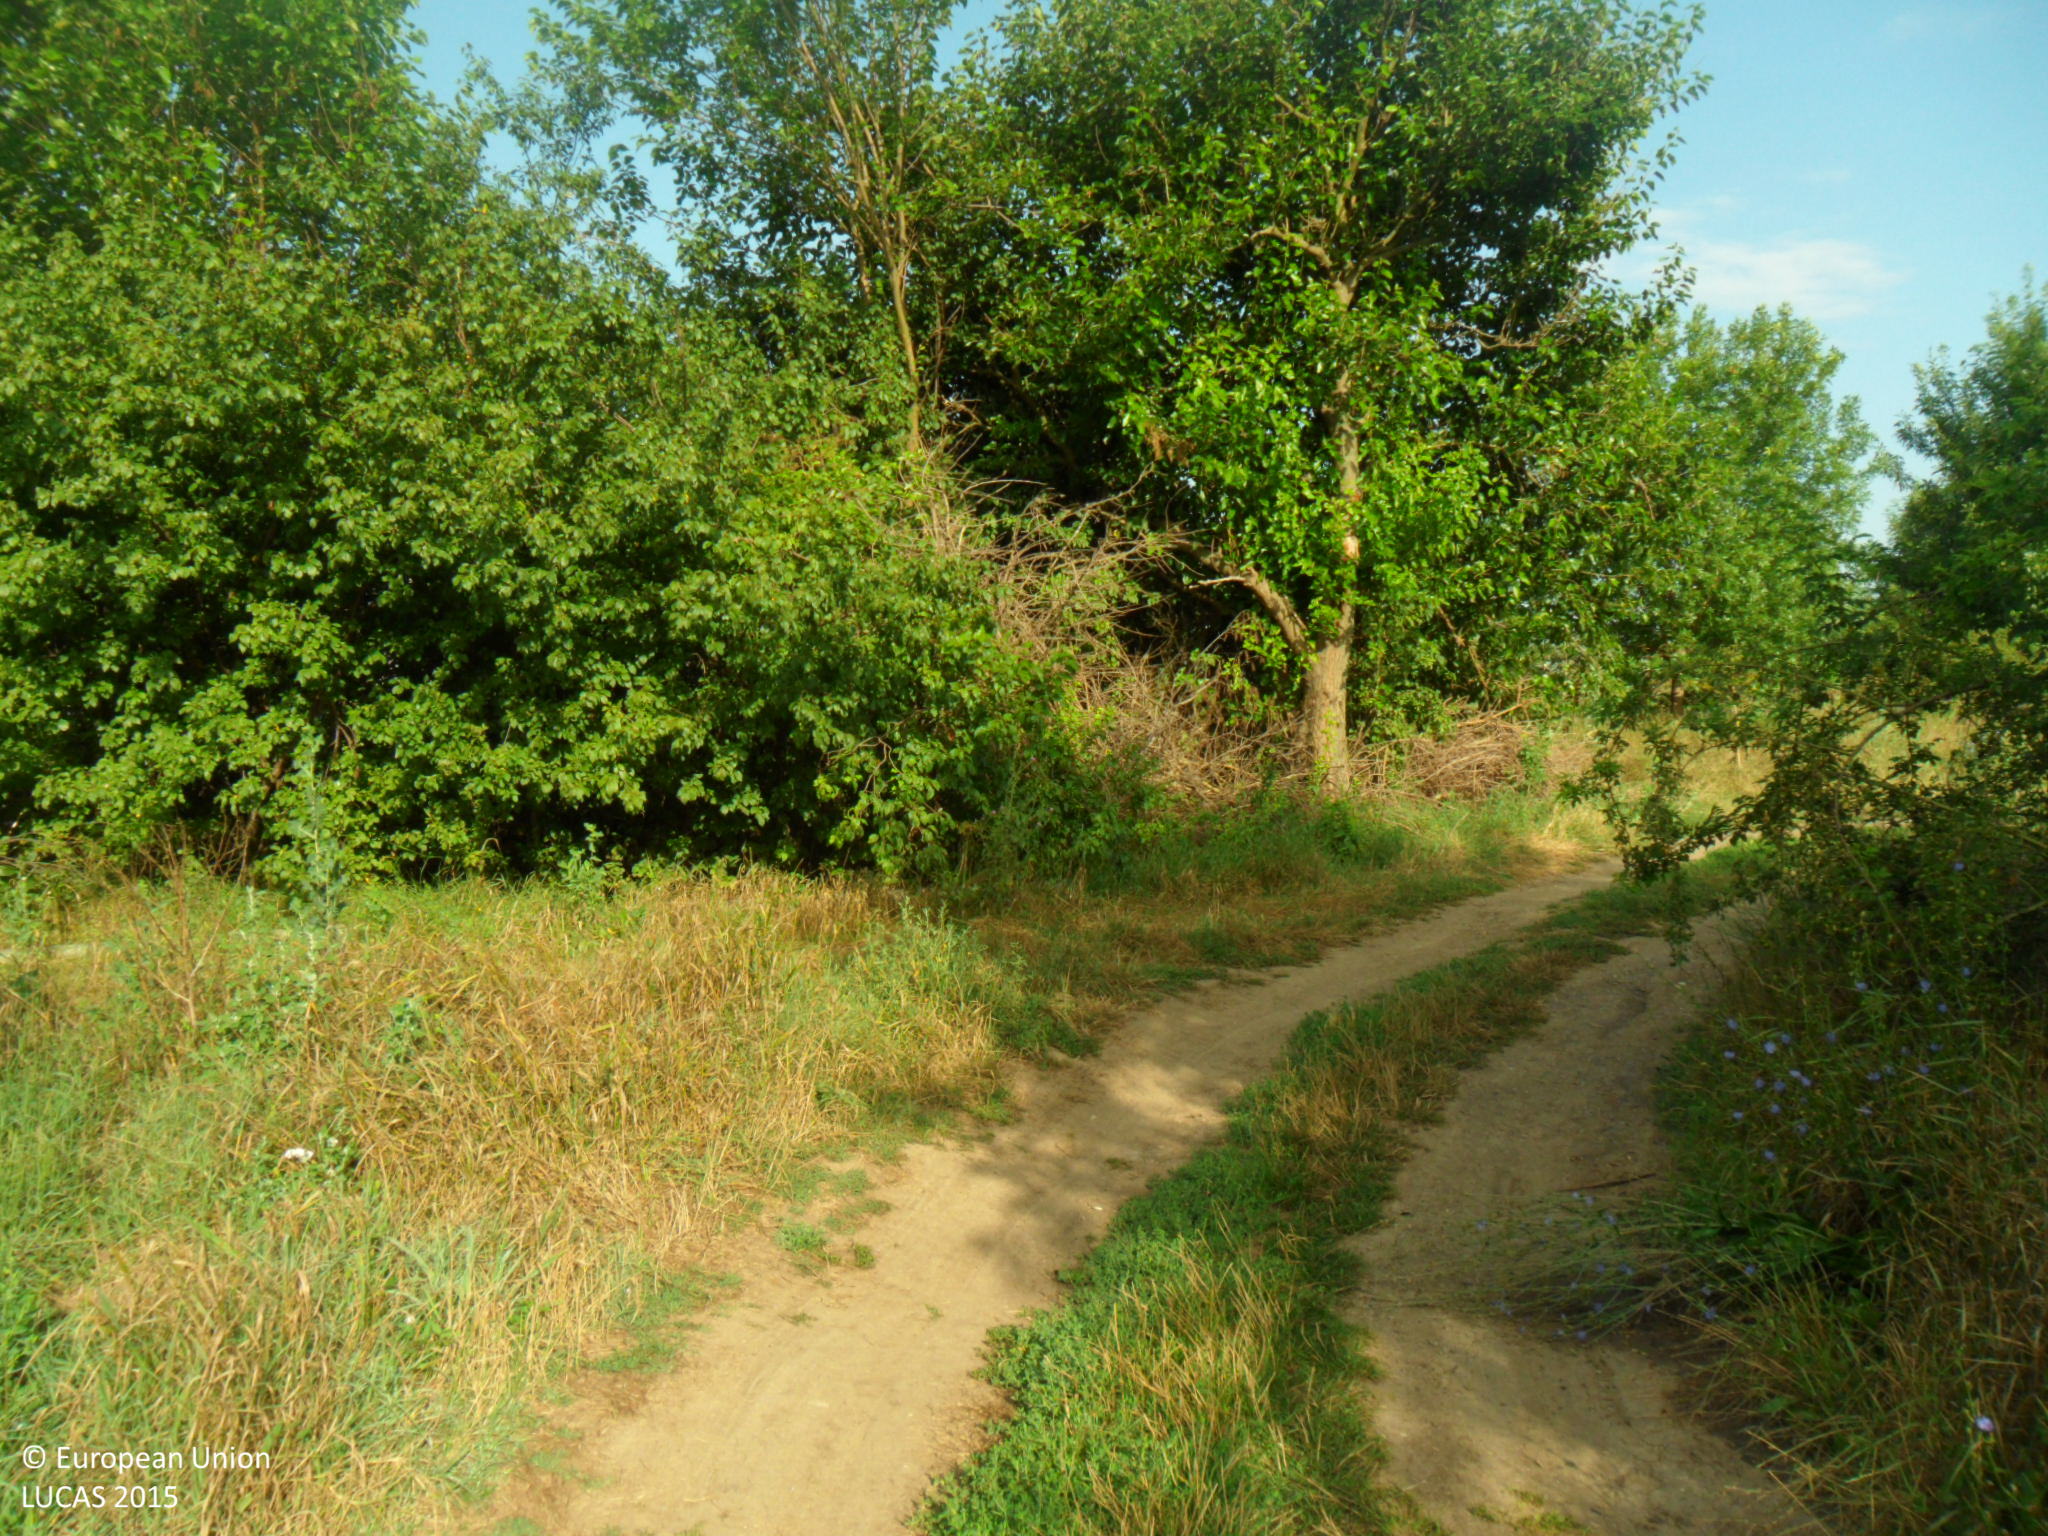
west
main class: Cropland
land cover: Maize
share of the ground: > 75 %
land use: Agriculture (excluding fallow land and kitchen gardens)
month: July
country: BG
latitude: 43.1914
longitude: 27.0086
